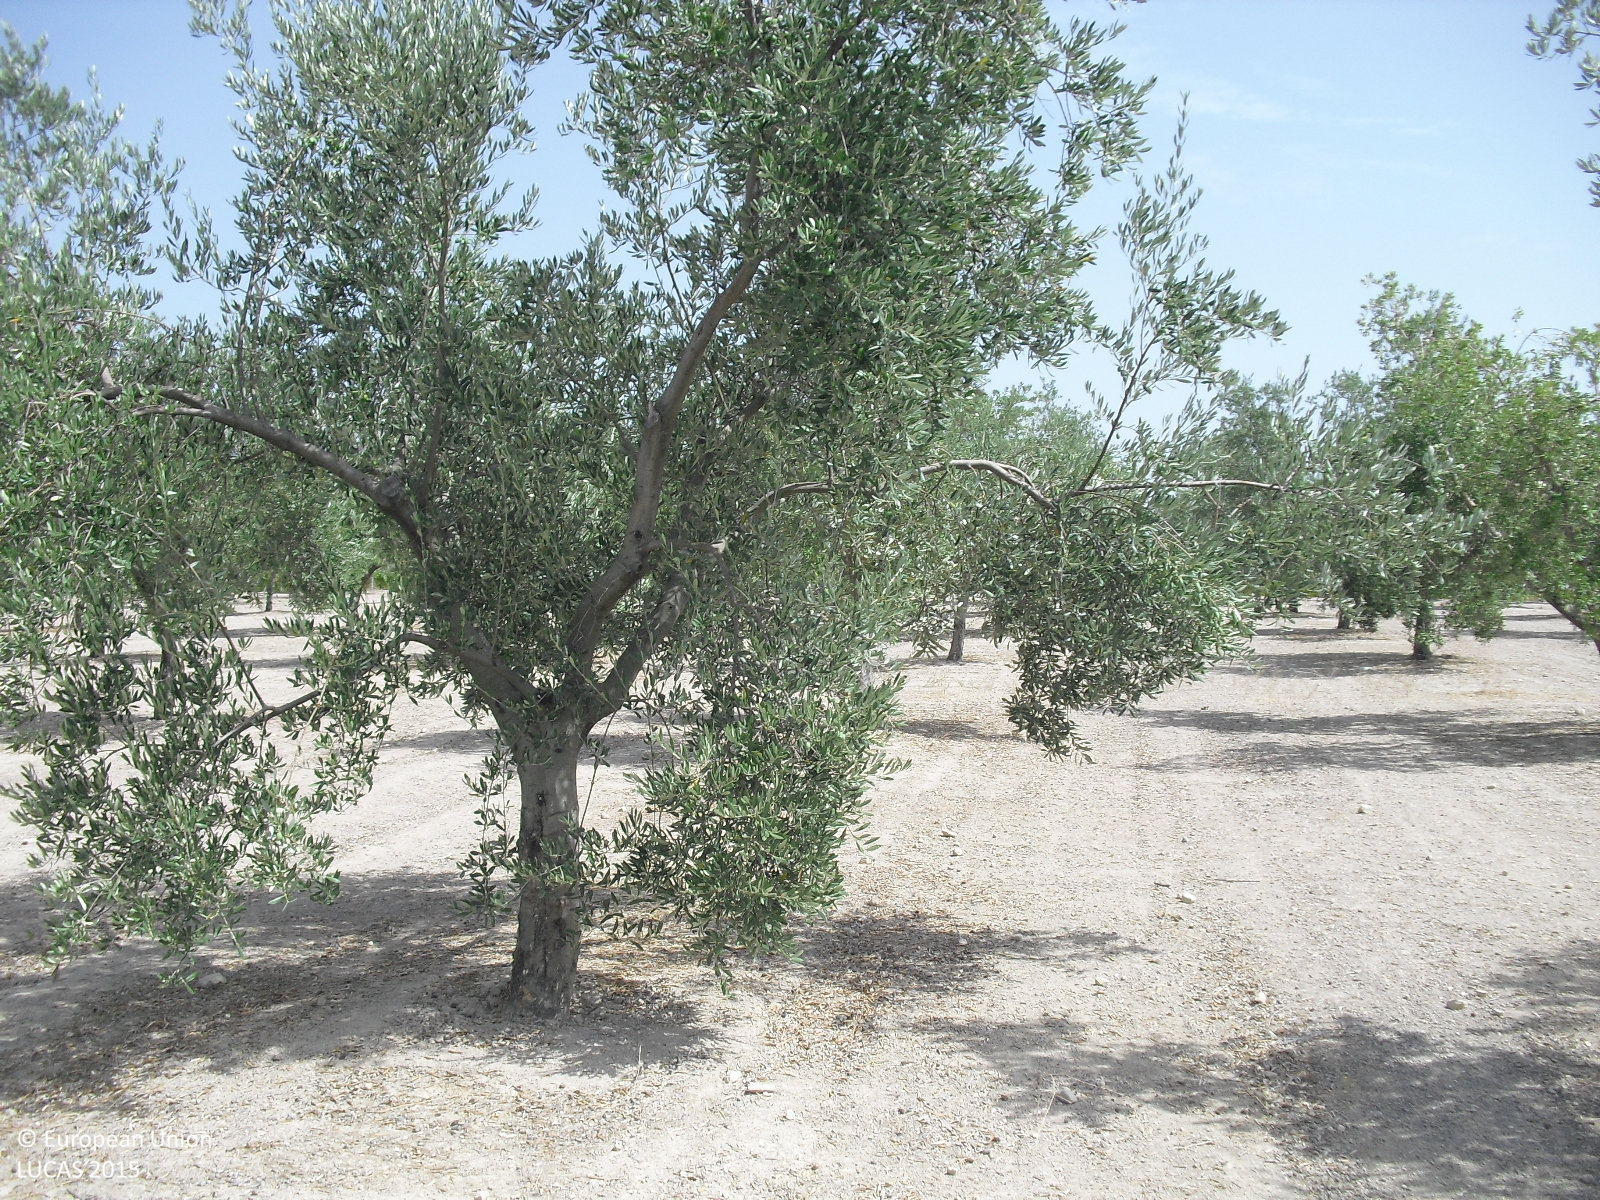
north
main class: Cropland
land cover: Olive groves
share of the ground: 25 - 50 %
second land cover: Other bare soil
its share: > 75 %
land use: Agriculture (excluding fallow land and kitchen gardens)
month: August
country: ES
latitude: 37.3527
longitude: -4.4631
